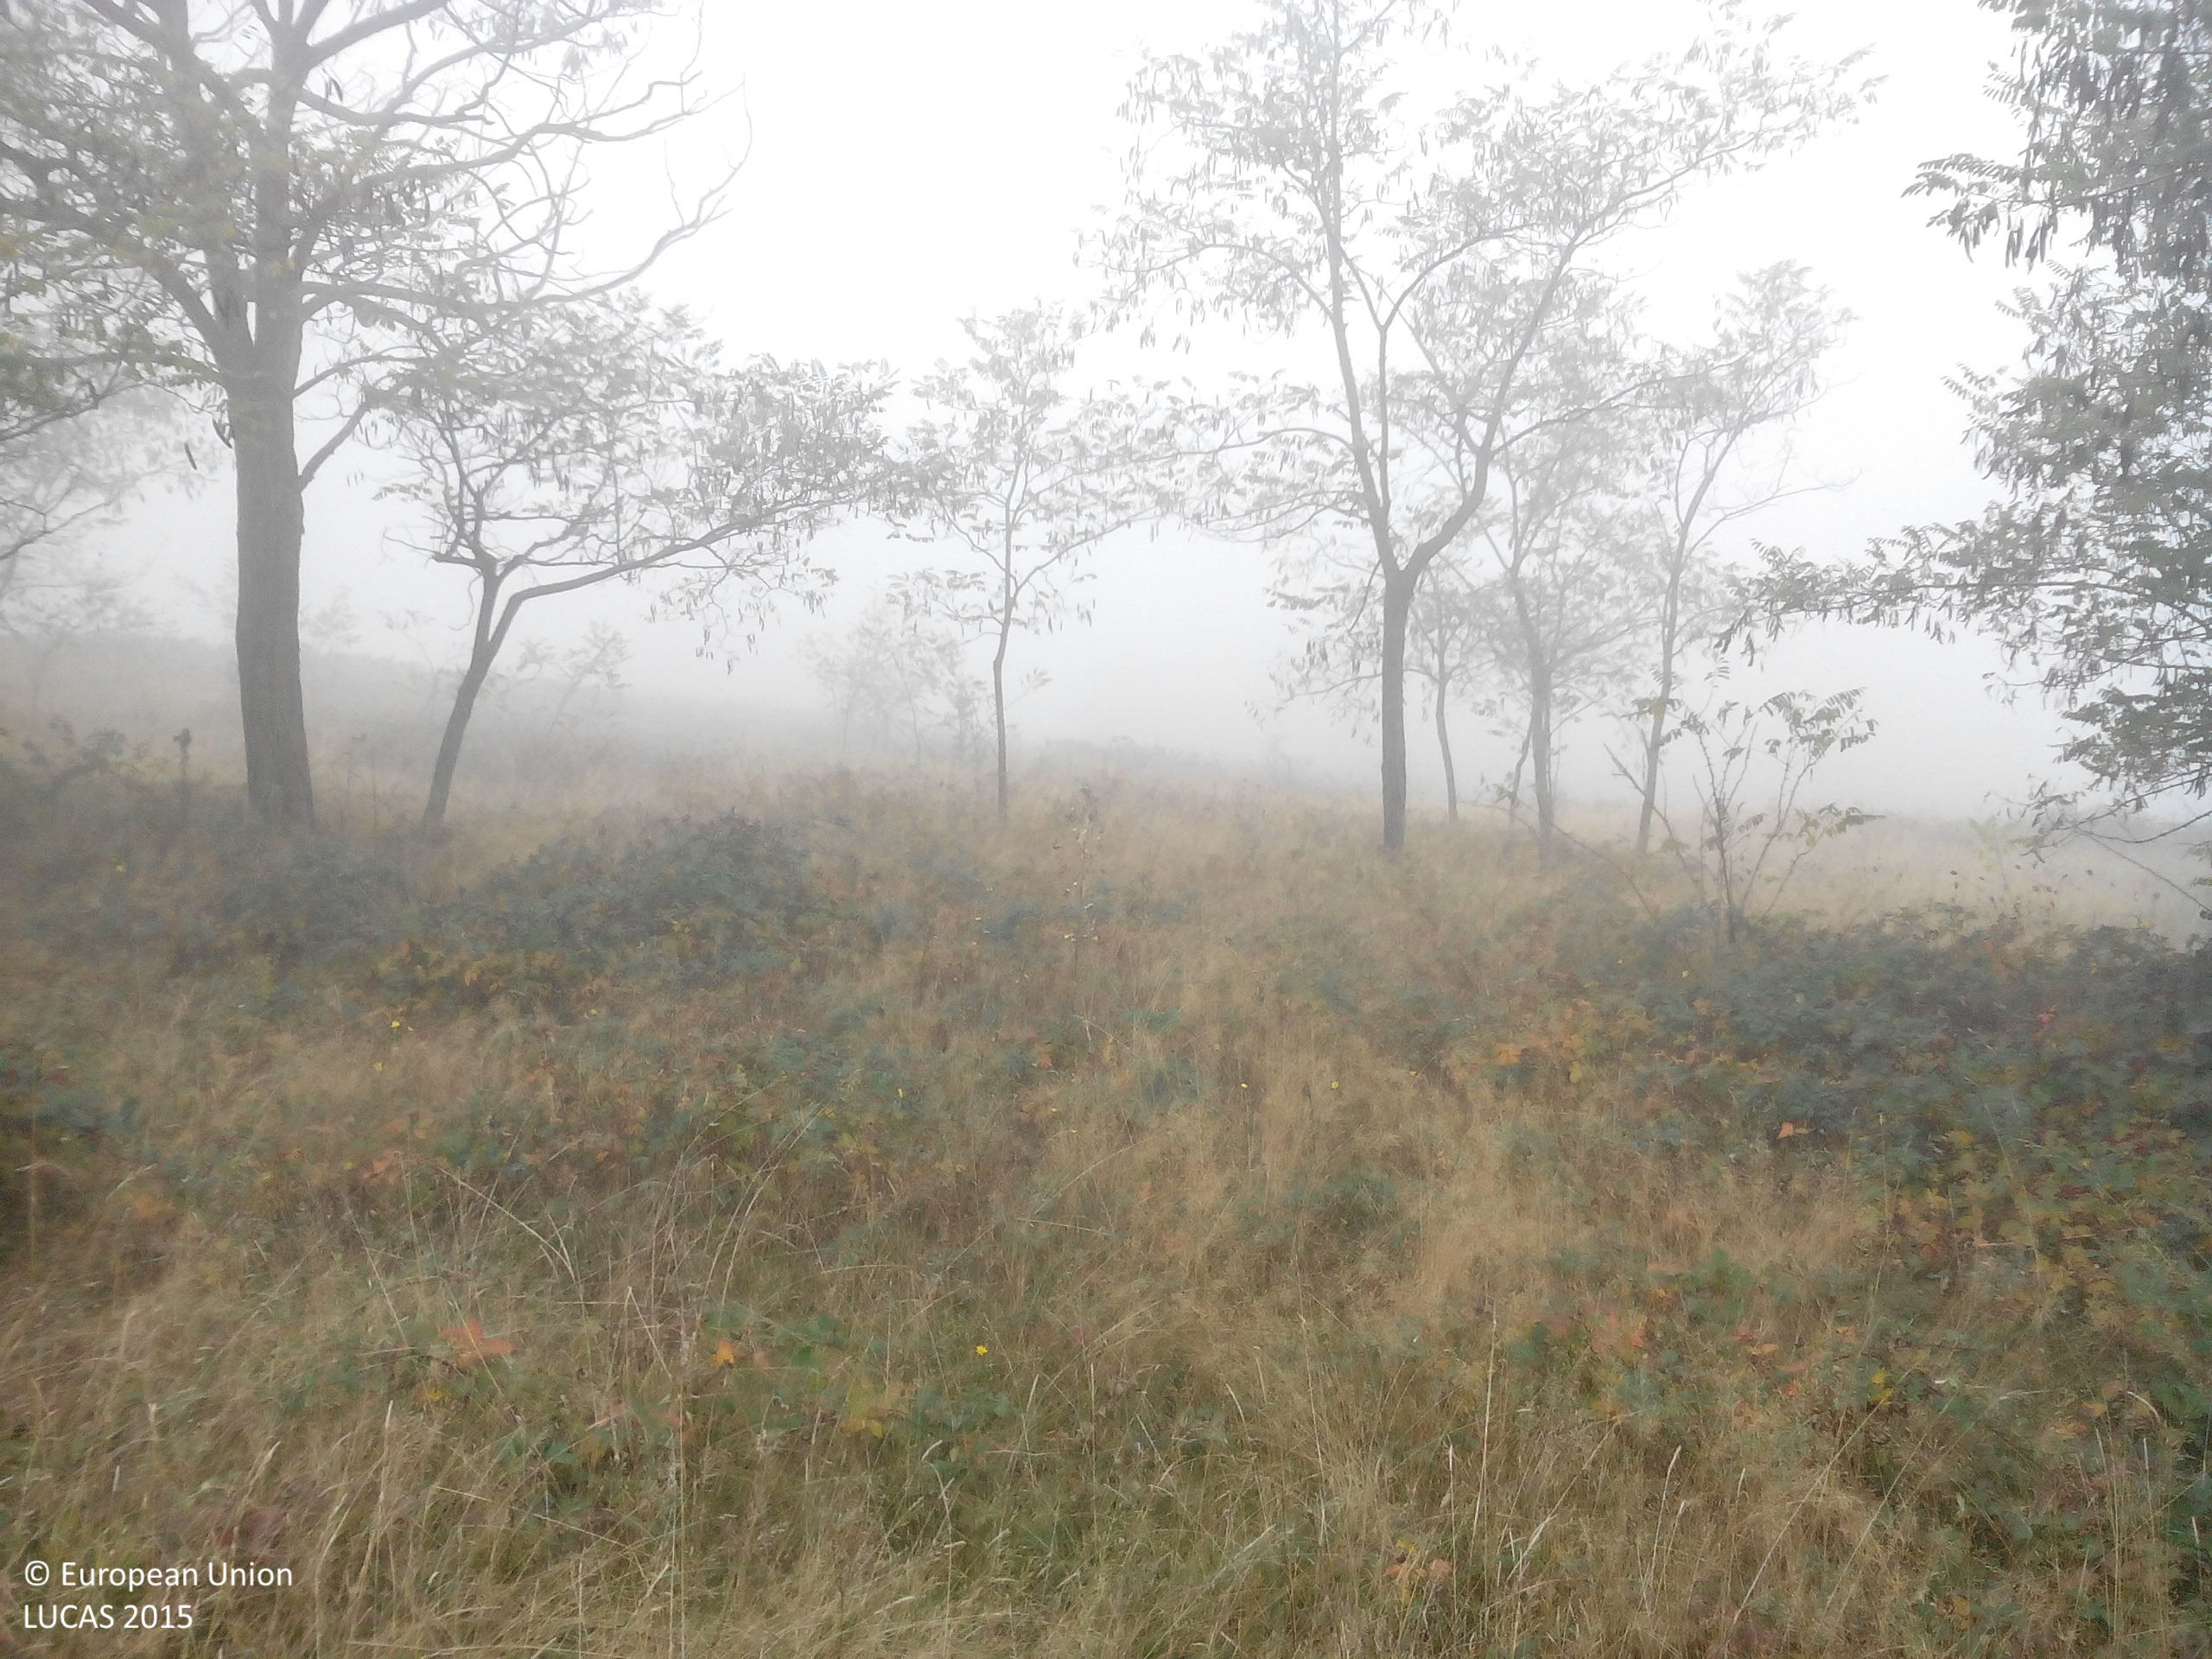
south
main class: Grassland
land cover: Grassland without tree/shrub cover
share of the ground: > 75 %
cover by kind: herbaceous plants 100 %
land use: Agriculture (excluding fallow land and kitchen gardens)
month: October
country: BG
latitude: 43.0266
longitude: 24.0264
